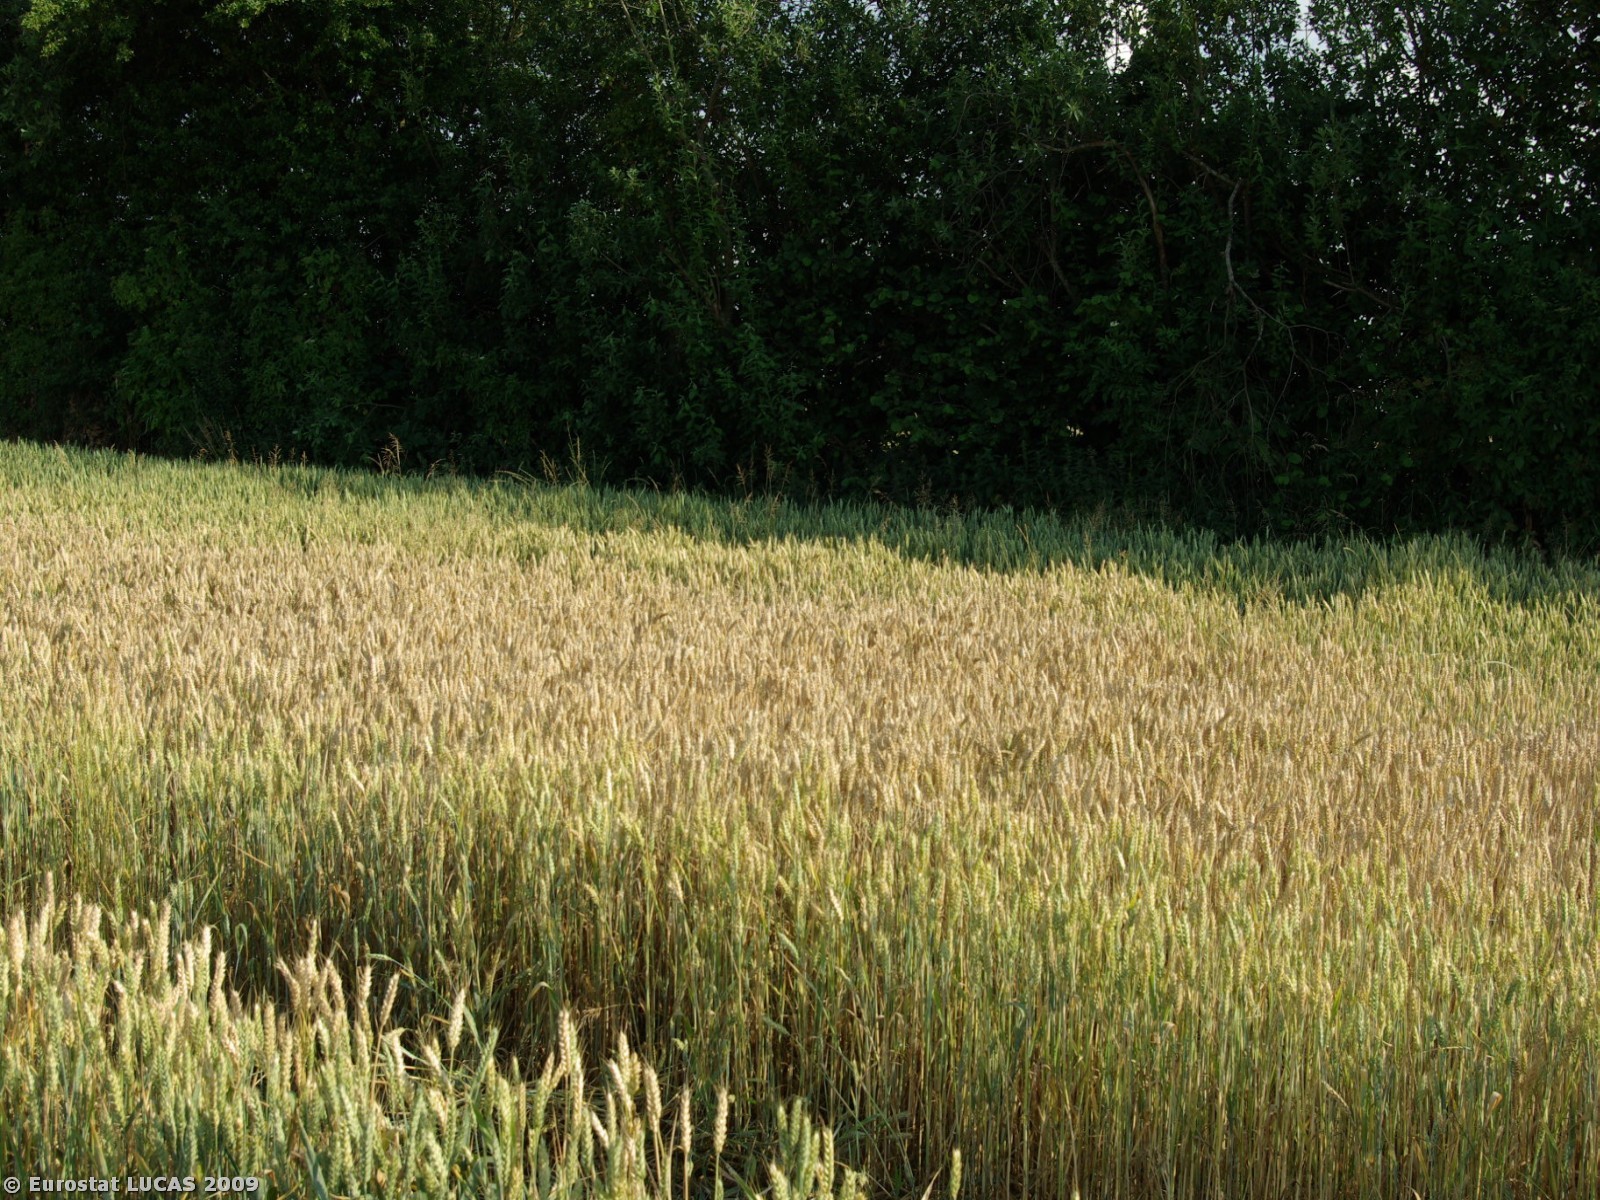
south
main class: Cropland
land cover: Common wheat
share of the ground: > 75 %
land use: Agriculture (excluding fallow land and kitchen gardens)
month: July
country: DK
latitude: 55.0191
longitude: 9.7343
